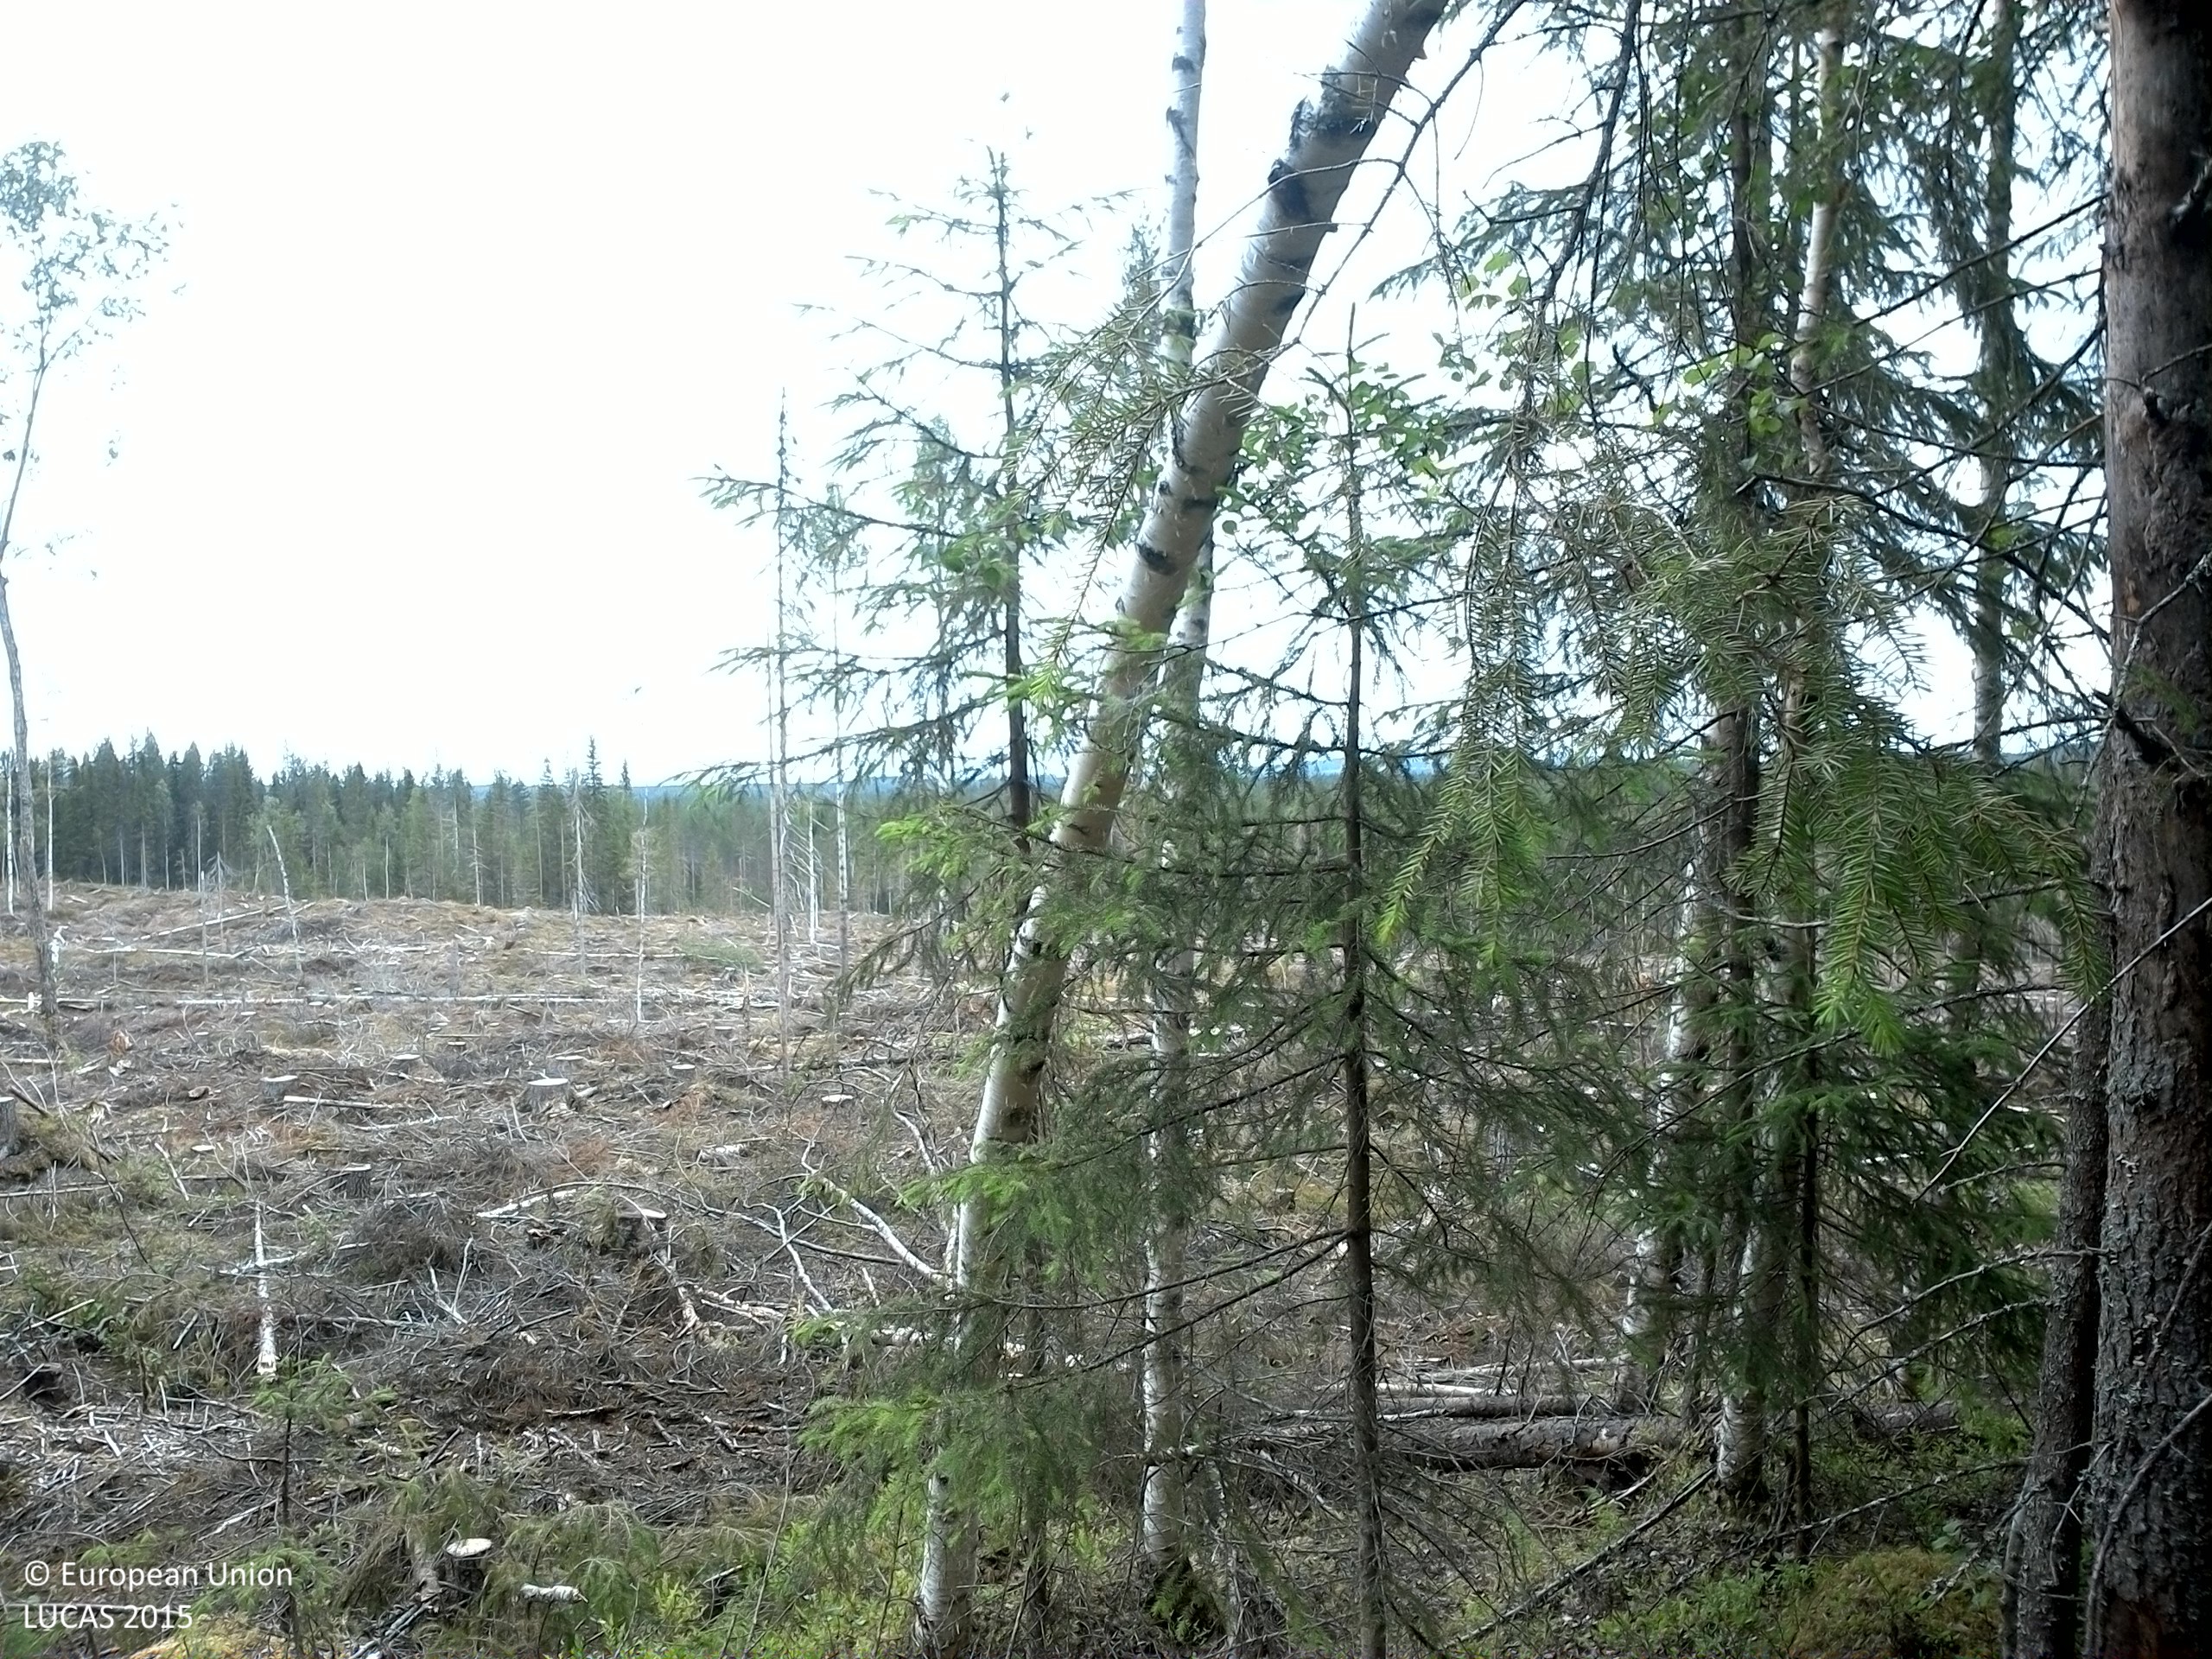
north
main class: Woodland
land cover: Spruce dominated mixed woodland
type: boreal forest
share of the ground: 50 - 75 %
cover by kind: coniferous forest trees 50 %, broadleaved forest trees 20 %, shrubs 20 %, lichens and mosses 10 %
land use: Forestry
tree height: > 5 m
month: July
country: SE
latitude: 63.6042
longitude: 17.4934
